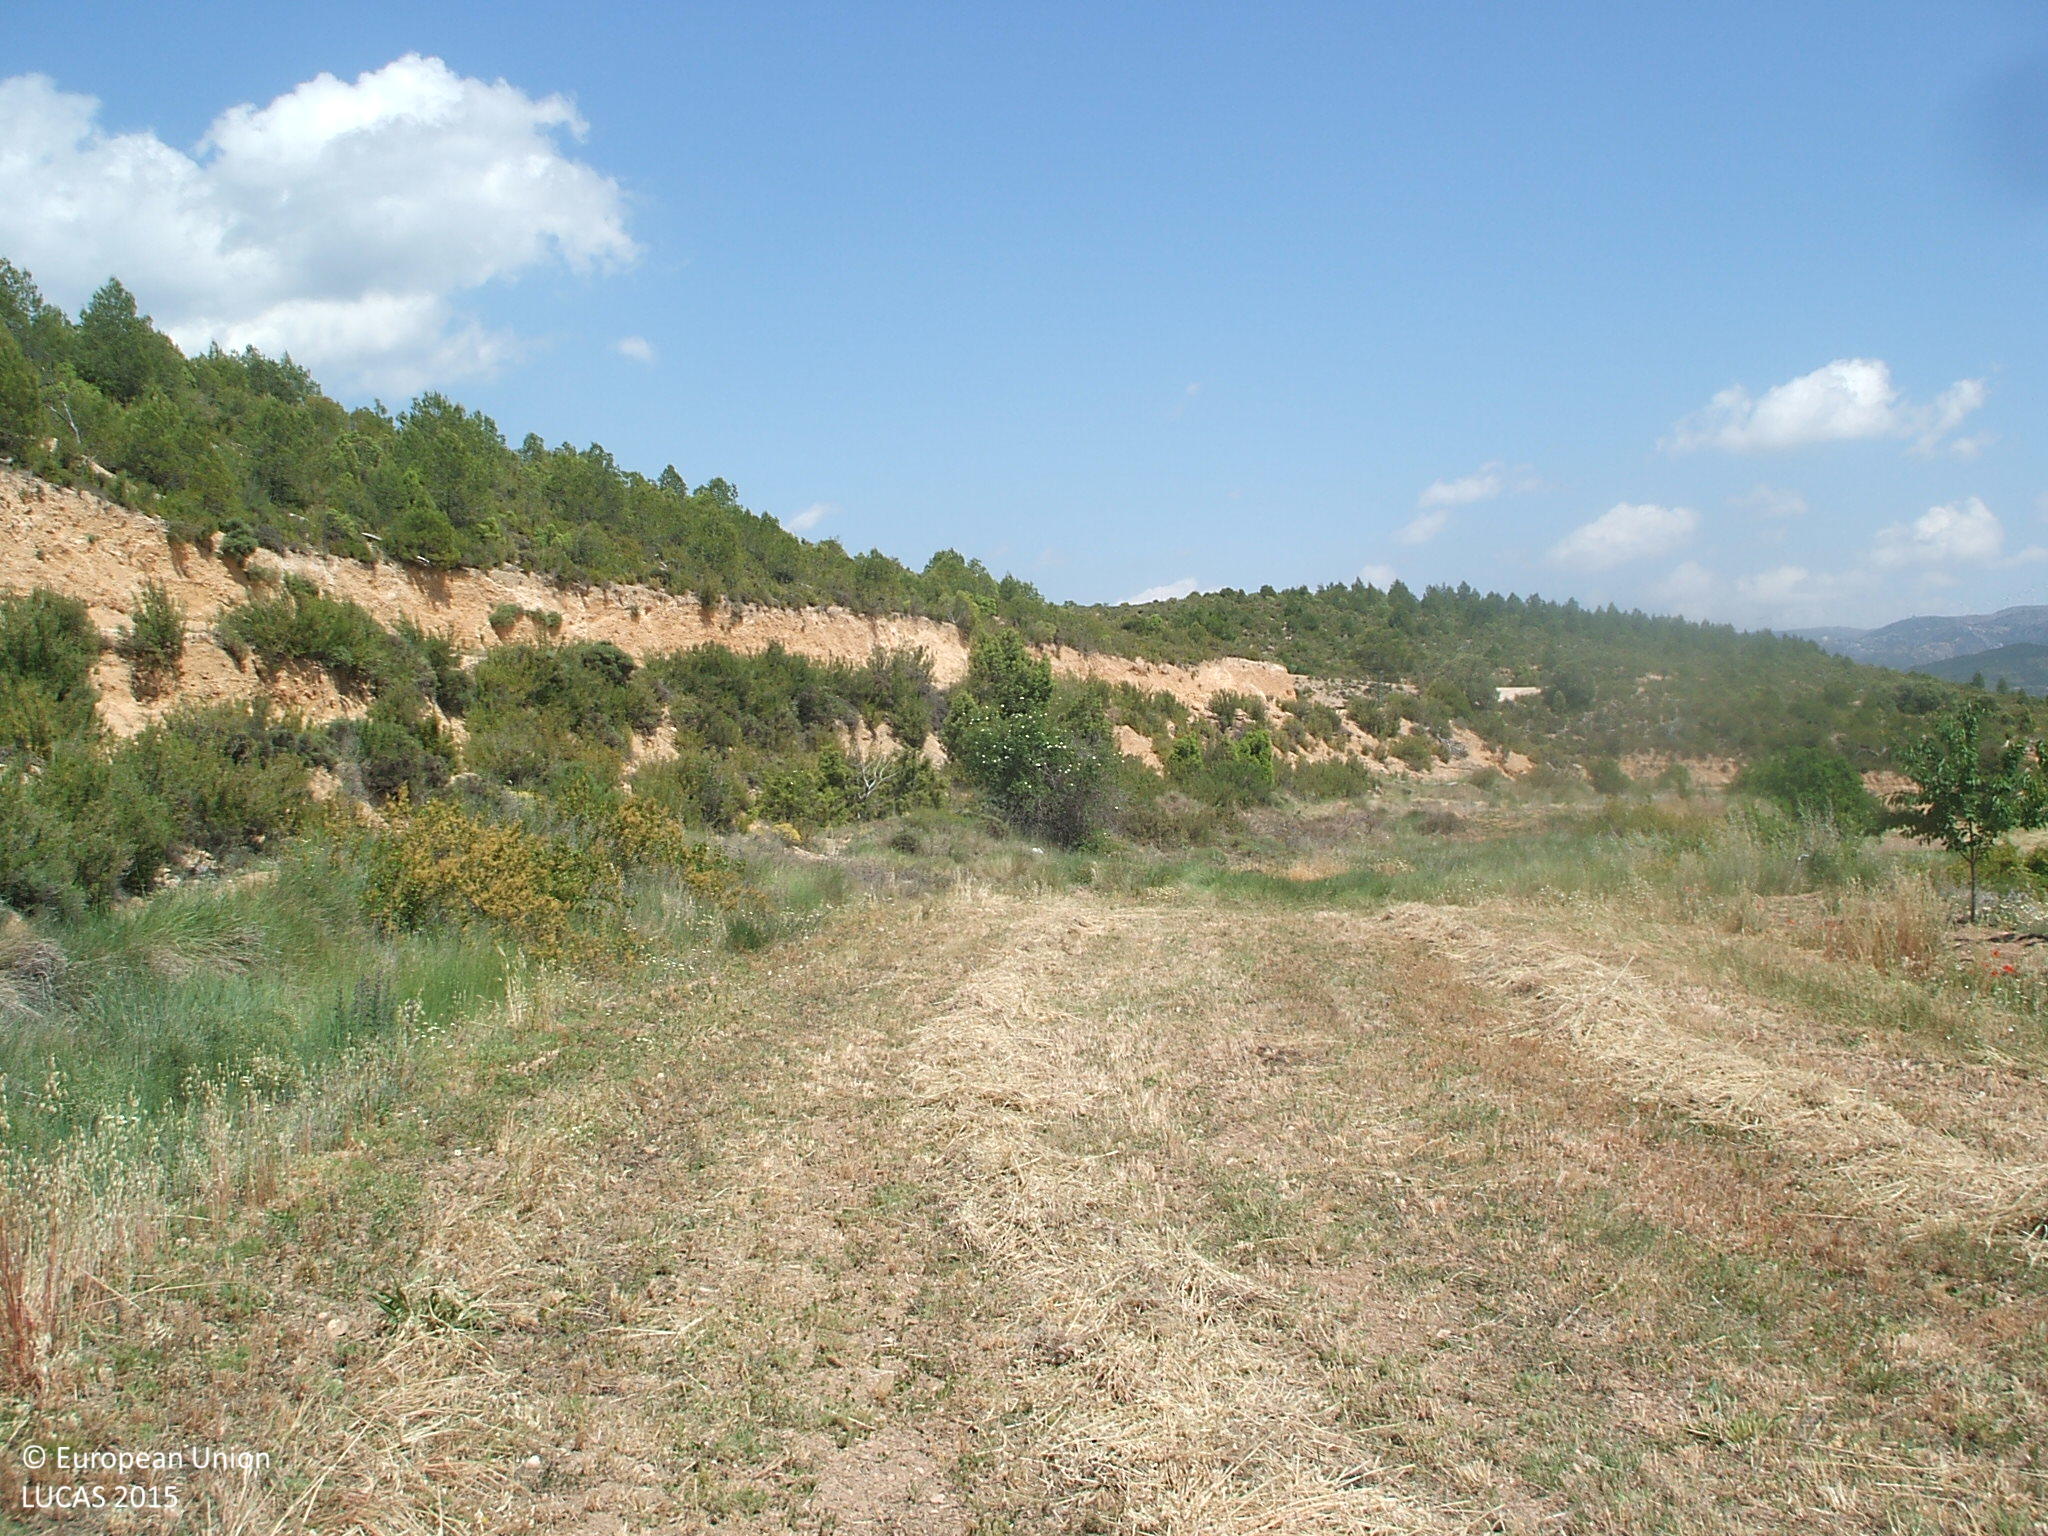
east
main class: Cropland
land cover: Oats
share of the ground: < 10 %
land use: Agriculture (excluding fallow land and kitchen gardens)
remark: Harvested field
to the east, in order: Oats; Shruby margins; Ditches and canals; Tracks; Pine dominated coniferous woodland; Shruby margins; Spontaneously vegetated surfaces; Shruby margins; Pine dominated mixed woodland; Pine dominated coniferous woodland; Tracks; Shrubland with sparse tree cover; Shruby margins; Barley; Abandoned hedges
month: May
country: ES
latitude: 40.7180
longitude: -0.2014
